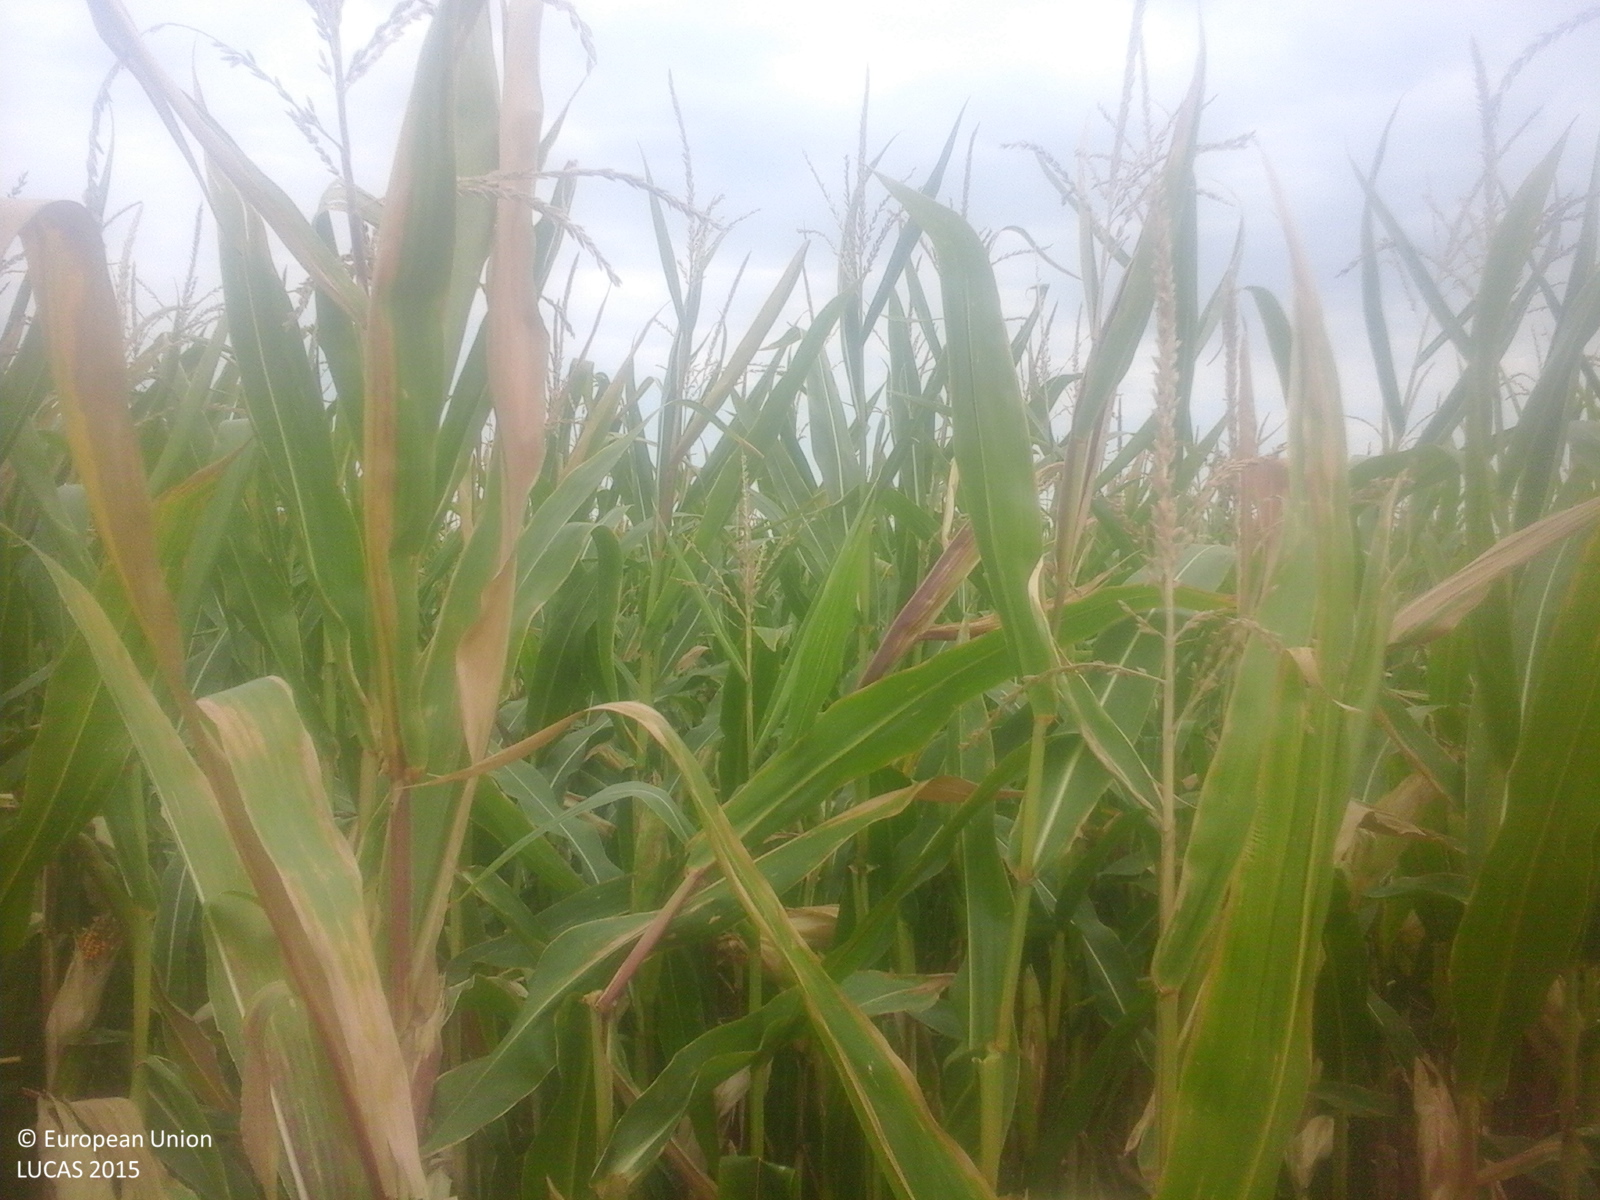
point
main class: Cropland
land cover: Maize
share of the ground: > 75 %
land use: Agriculture (excluding fallow land and kitchen gardens)
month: September
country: RO
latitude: 47.7685
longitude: 22.6162
